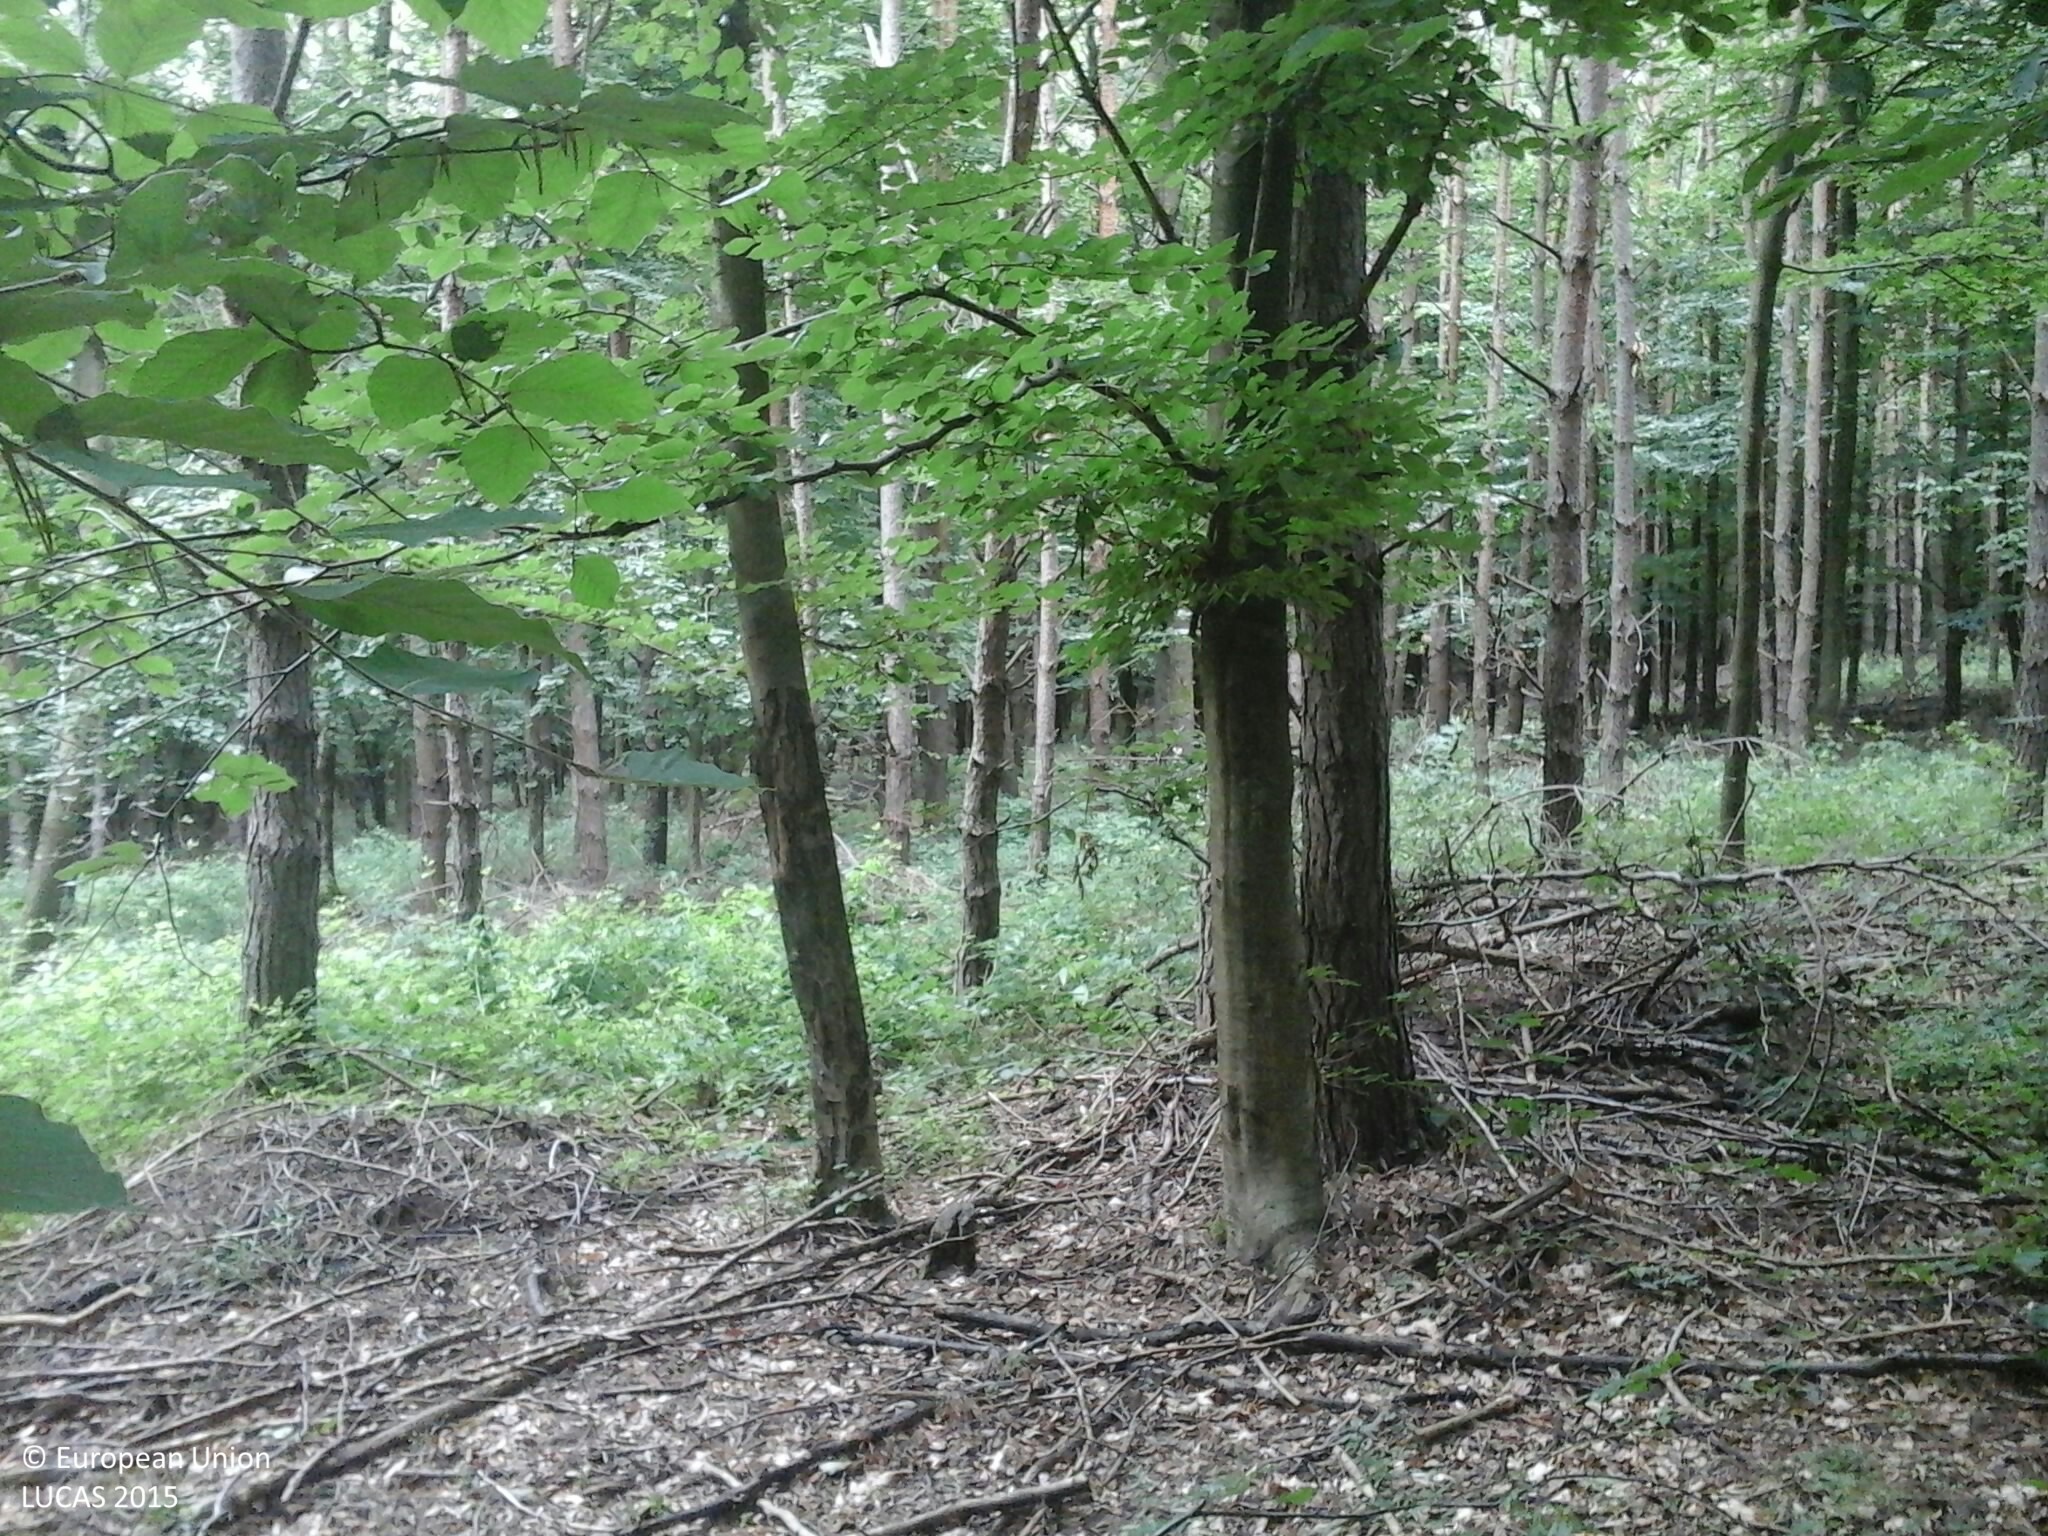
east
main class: Woodland
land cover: Pine dominated mixed woodland
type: hemiboreal forest and nemoral coniferous forest and mixed broadleaved-coniferous forest
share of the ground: > 75 %
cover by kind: coniferous forest trees 50 %, broadleaved forest trees 40 %, shrubs 5 %, herbaceous plants 5 %
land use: Forestry
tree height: > 5 m
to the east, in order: Pine dominated mixed woodland; Broadleaved woodland; Tracks; Broadleaved woodland
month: July
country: HU
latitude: 46.7998
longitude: 16.5665
